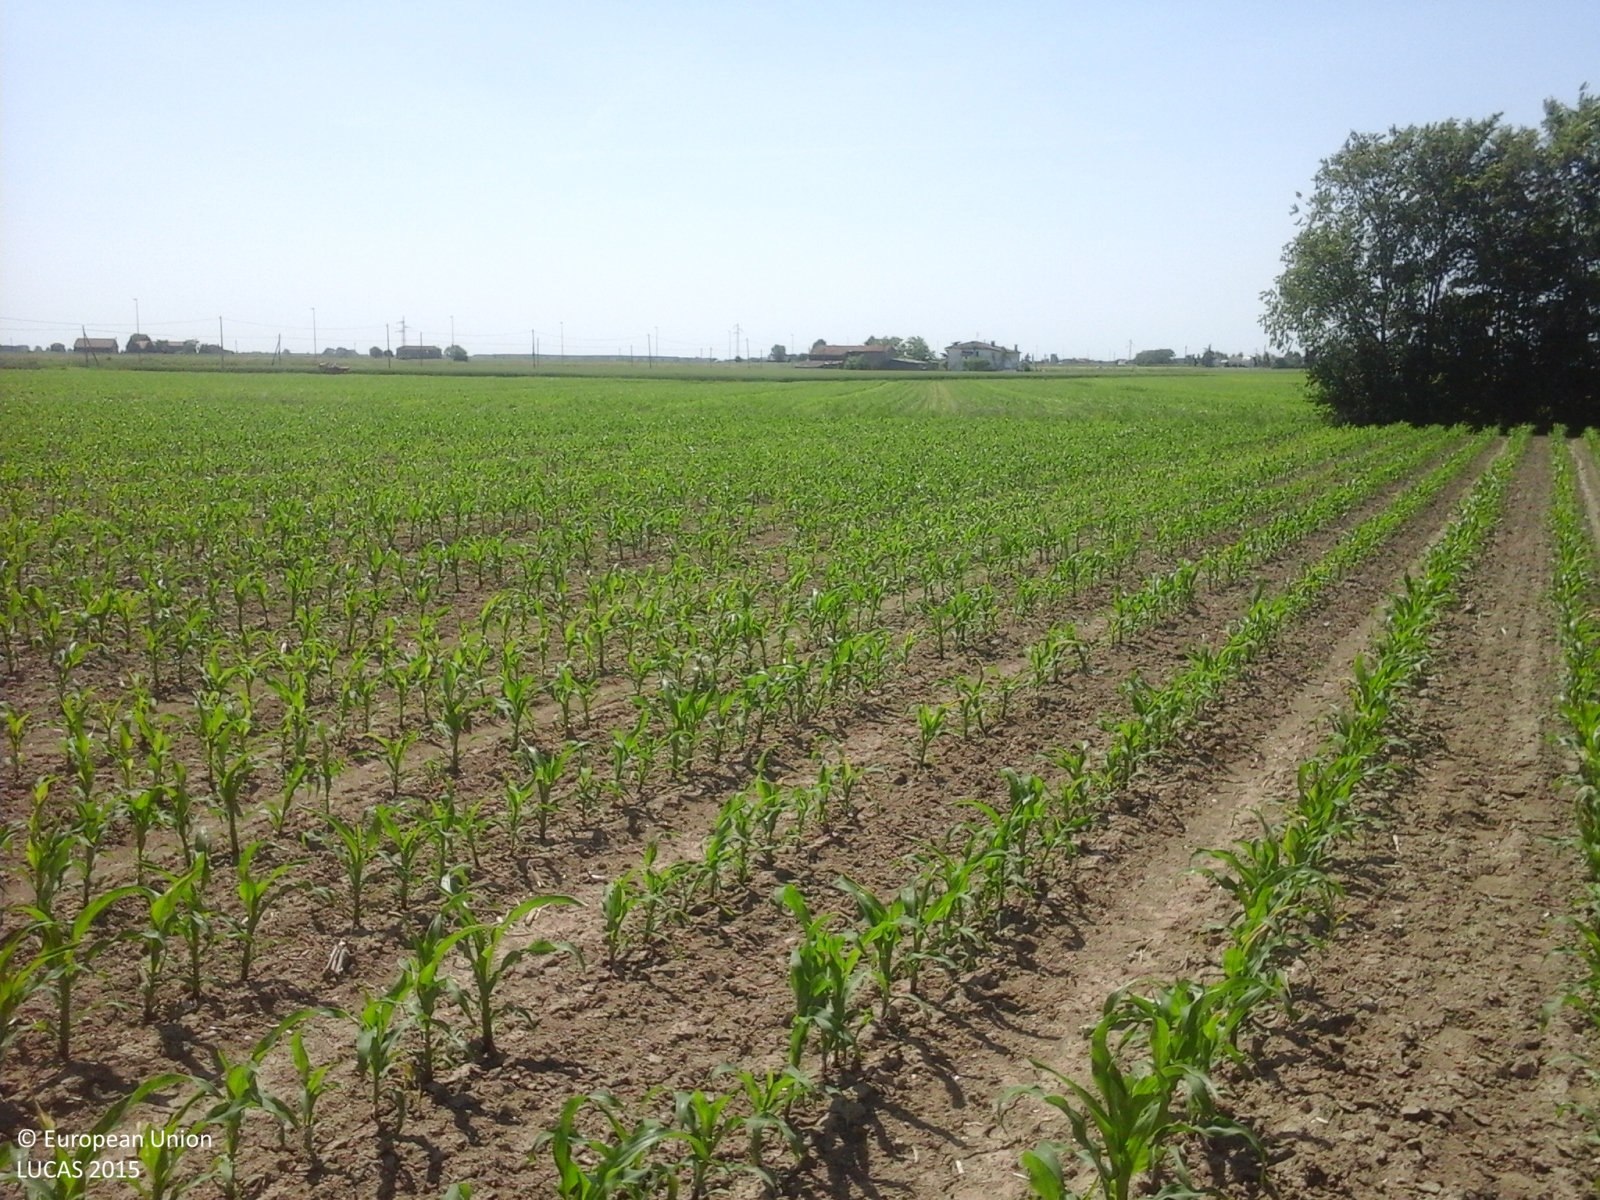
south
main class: Cropland
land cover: Maize
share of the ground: 10 - 25 %
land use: Agriculture (excluding fallow land and kitchen gardens)
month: May
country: IT
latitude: 44.9682
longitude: 11.6831
